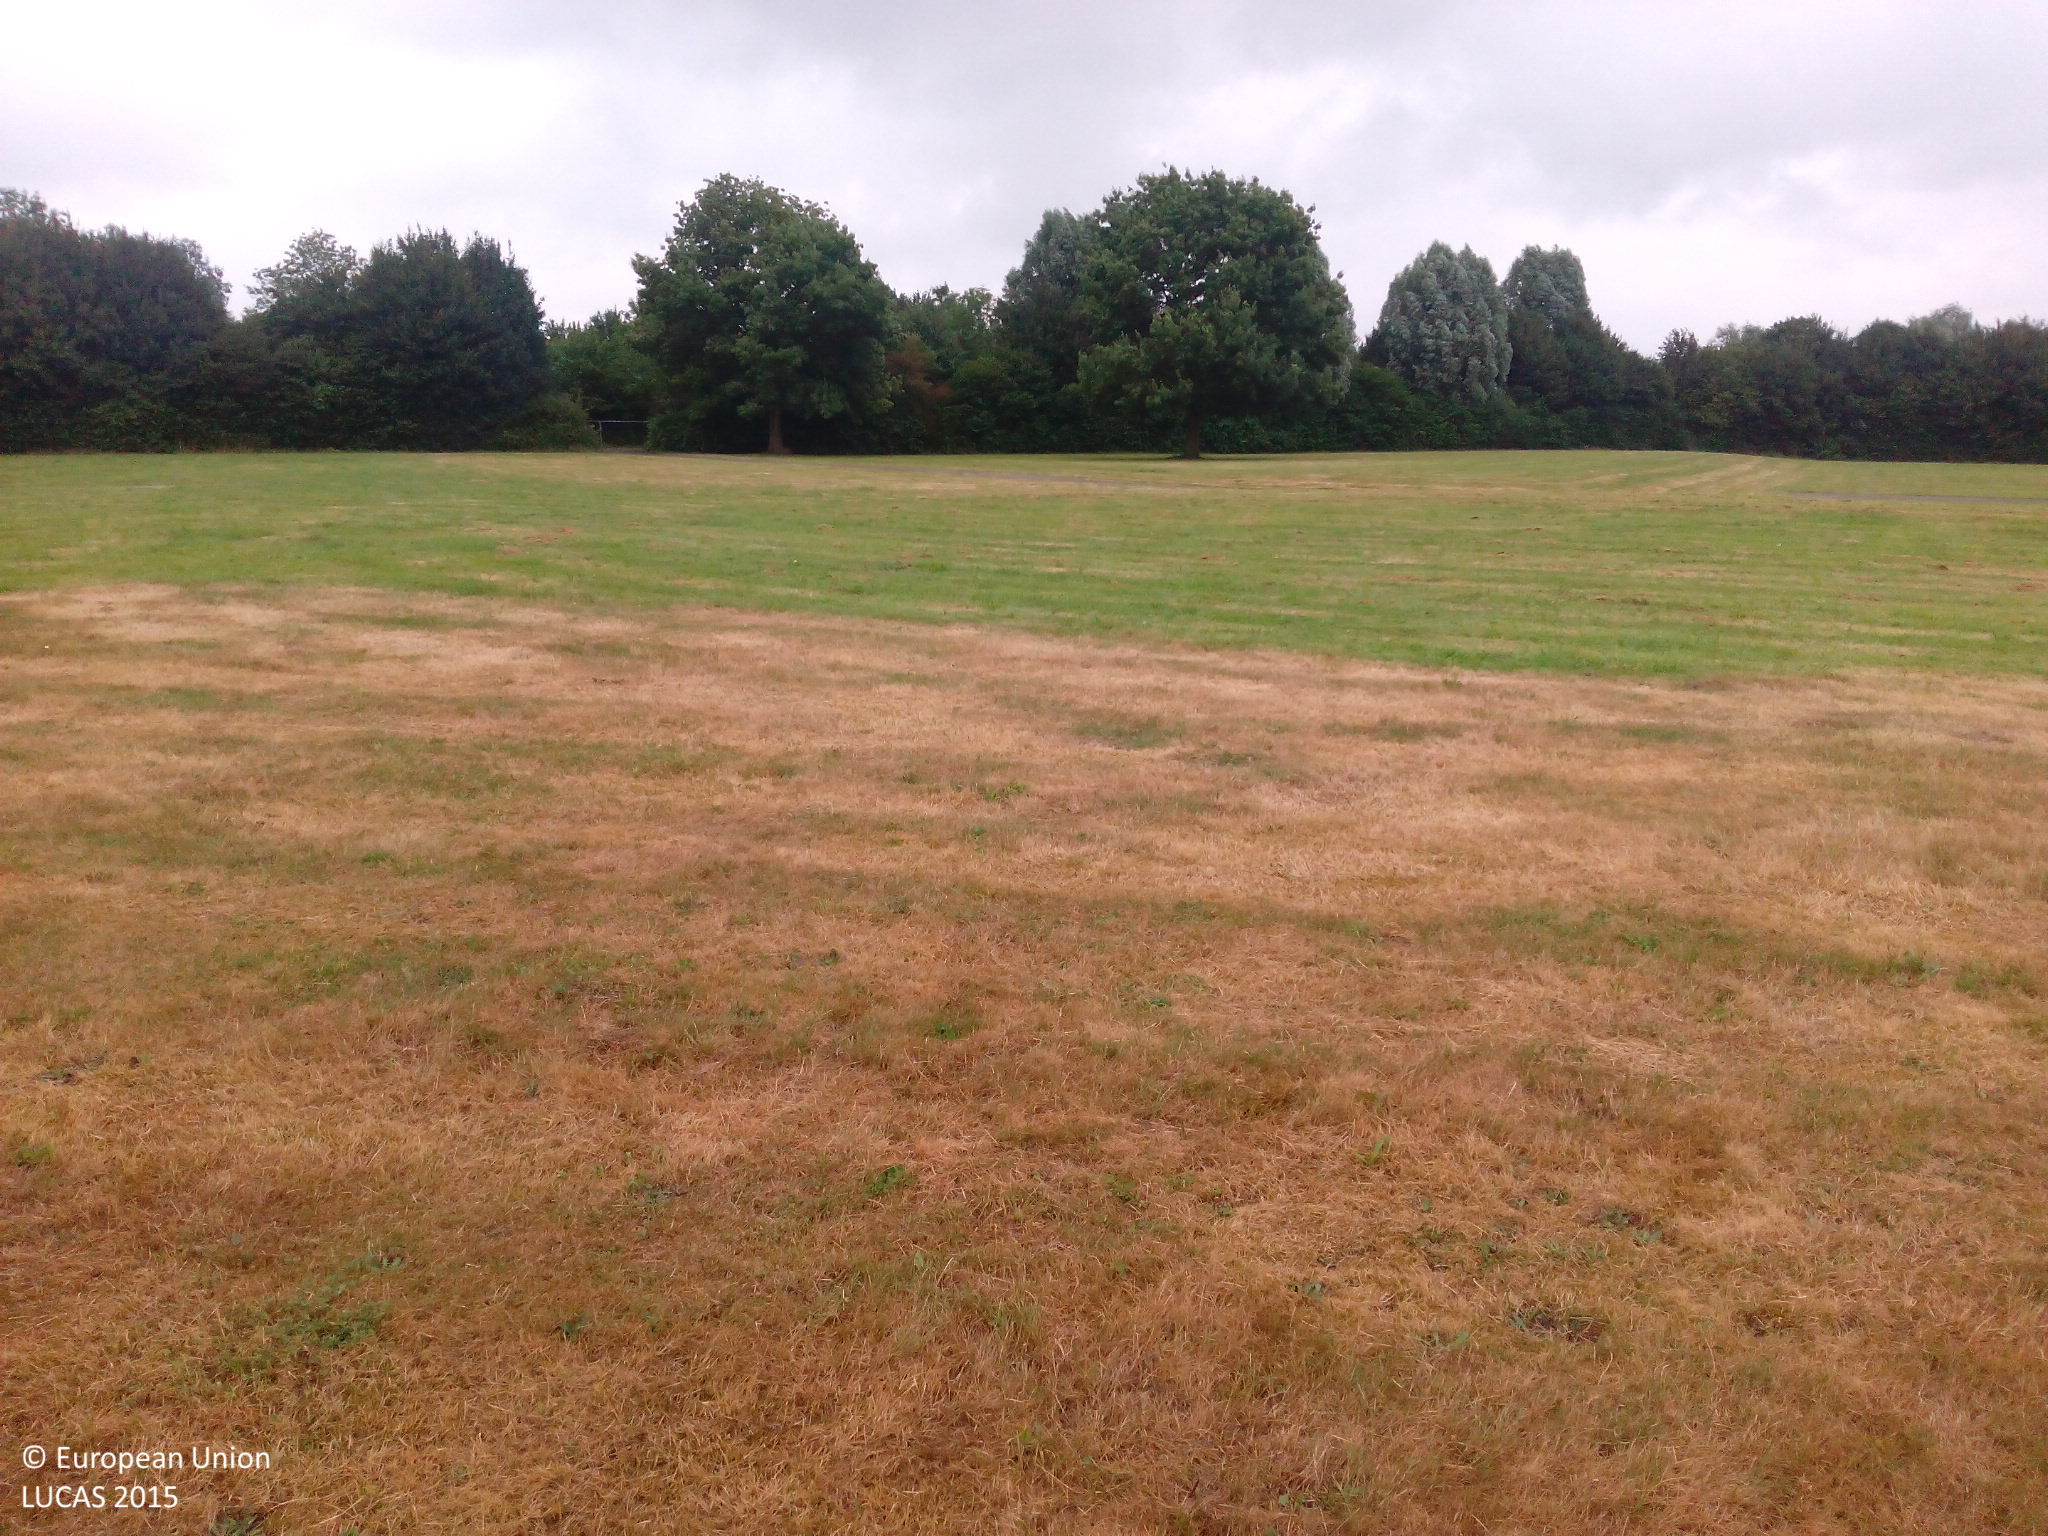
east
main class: Grassland
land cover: Grassland without tree/shrub cover
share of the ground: > 75 %
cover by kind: herbaceous plants 100 %
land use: Amenities, museums, leisure
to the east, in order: Grassland without tree/shrub cover; Paved roads, cycling and walking lanes; Grassland without tree/shrub cover; Single bushes/trees; Grassland without tree/shrub cover; Broadleaved woodland; Paved roads, cycling and walking lanes; Grass margins; Broadleaved woodland; Grass margins; Paved roads, cycling and walking lanes; Grass margins; Broadleaved woodland; Grassland without tree/shrub cover; Broadleaved woodland; Grassland without tree/shrub cover; Abandoned hedges; Paved roads, cycling and walking lanes; Broadleaved woodland; Grassland without tree/shrub cover
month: July
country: NL
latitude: 51.8258
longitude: 5.5439
